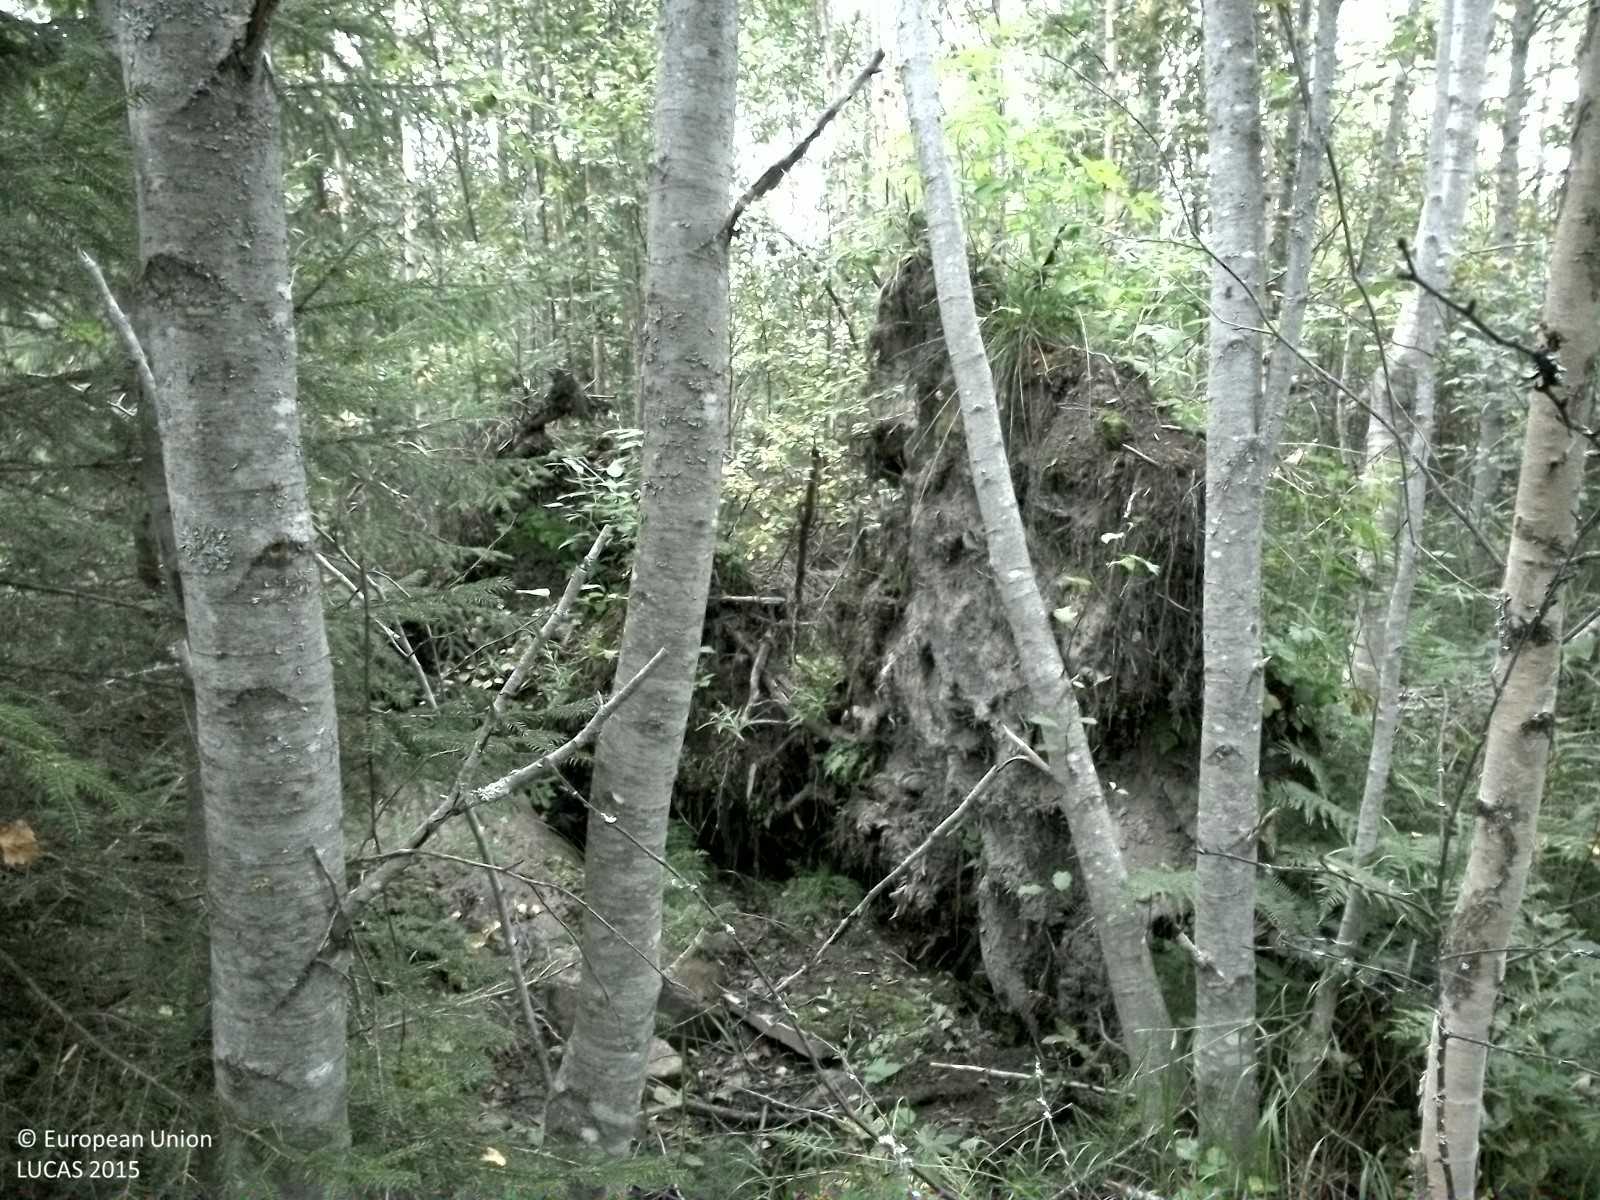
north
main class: Woodland
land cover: Spruce dominated mixed woodland
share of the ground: > 75 %
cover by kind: broadleaved forest trees 45 %, coniferous forest trees 30 %, herbaceous plants 25 %
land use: Forestry
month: September
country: SE
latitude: 62.4648
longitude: 16.2422
